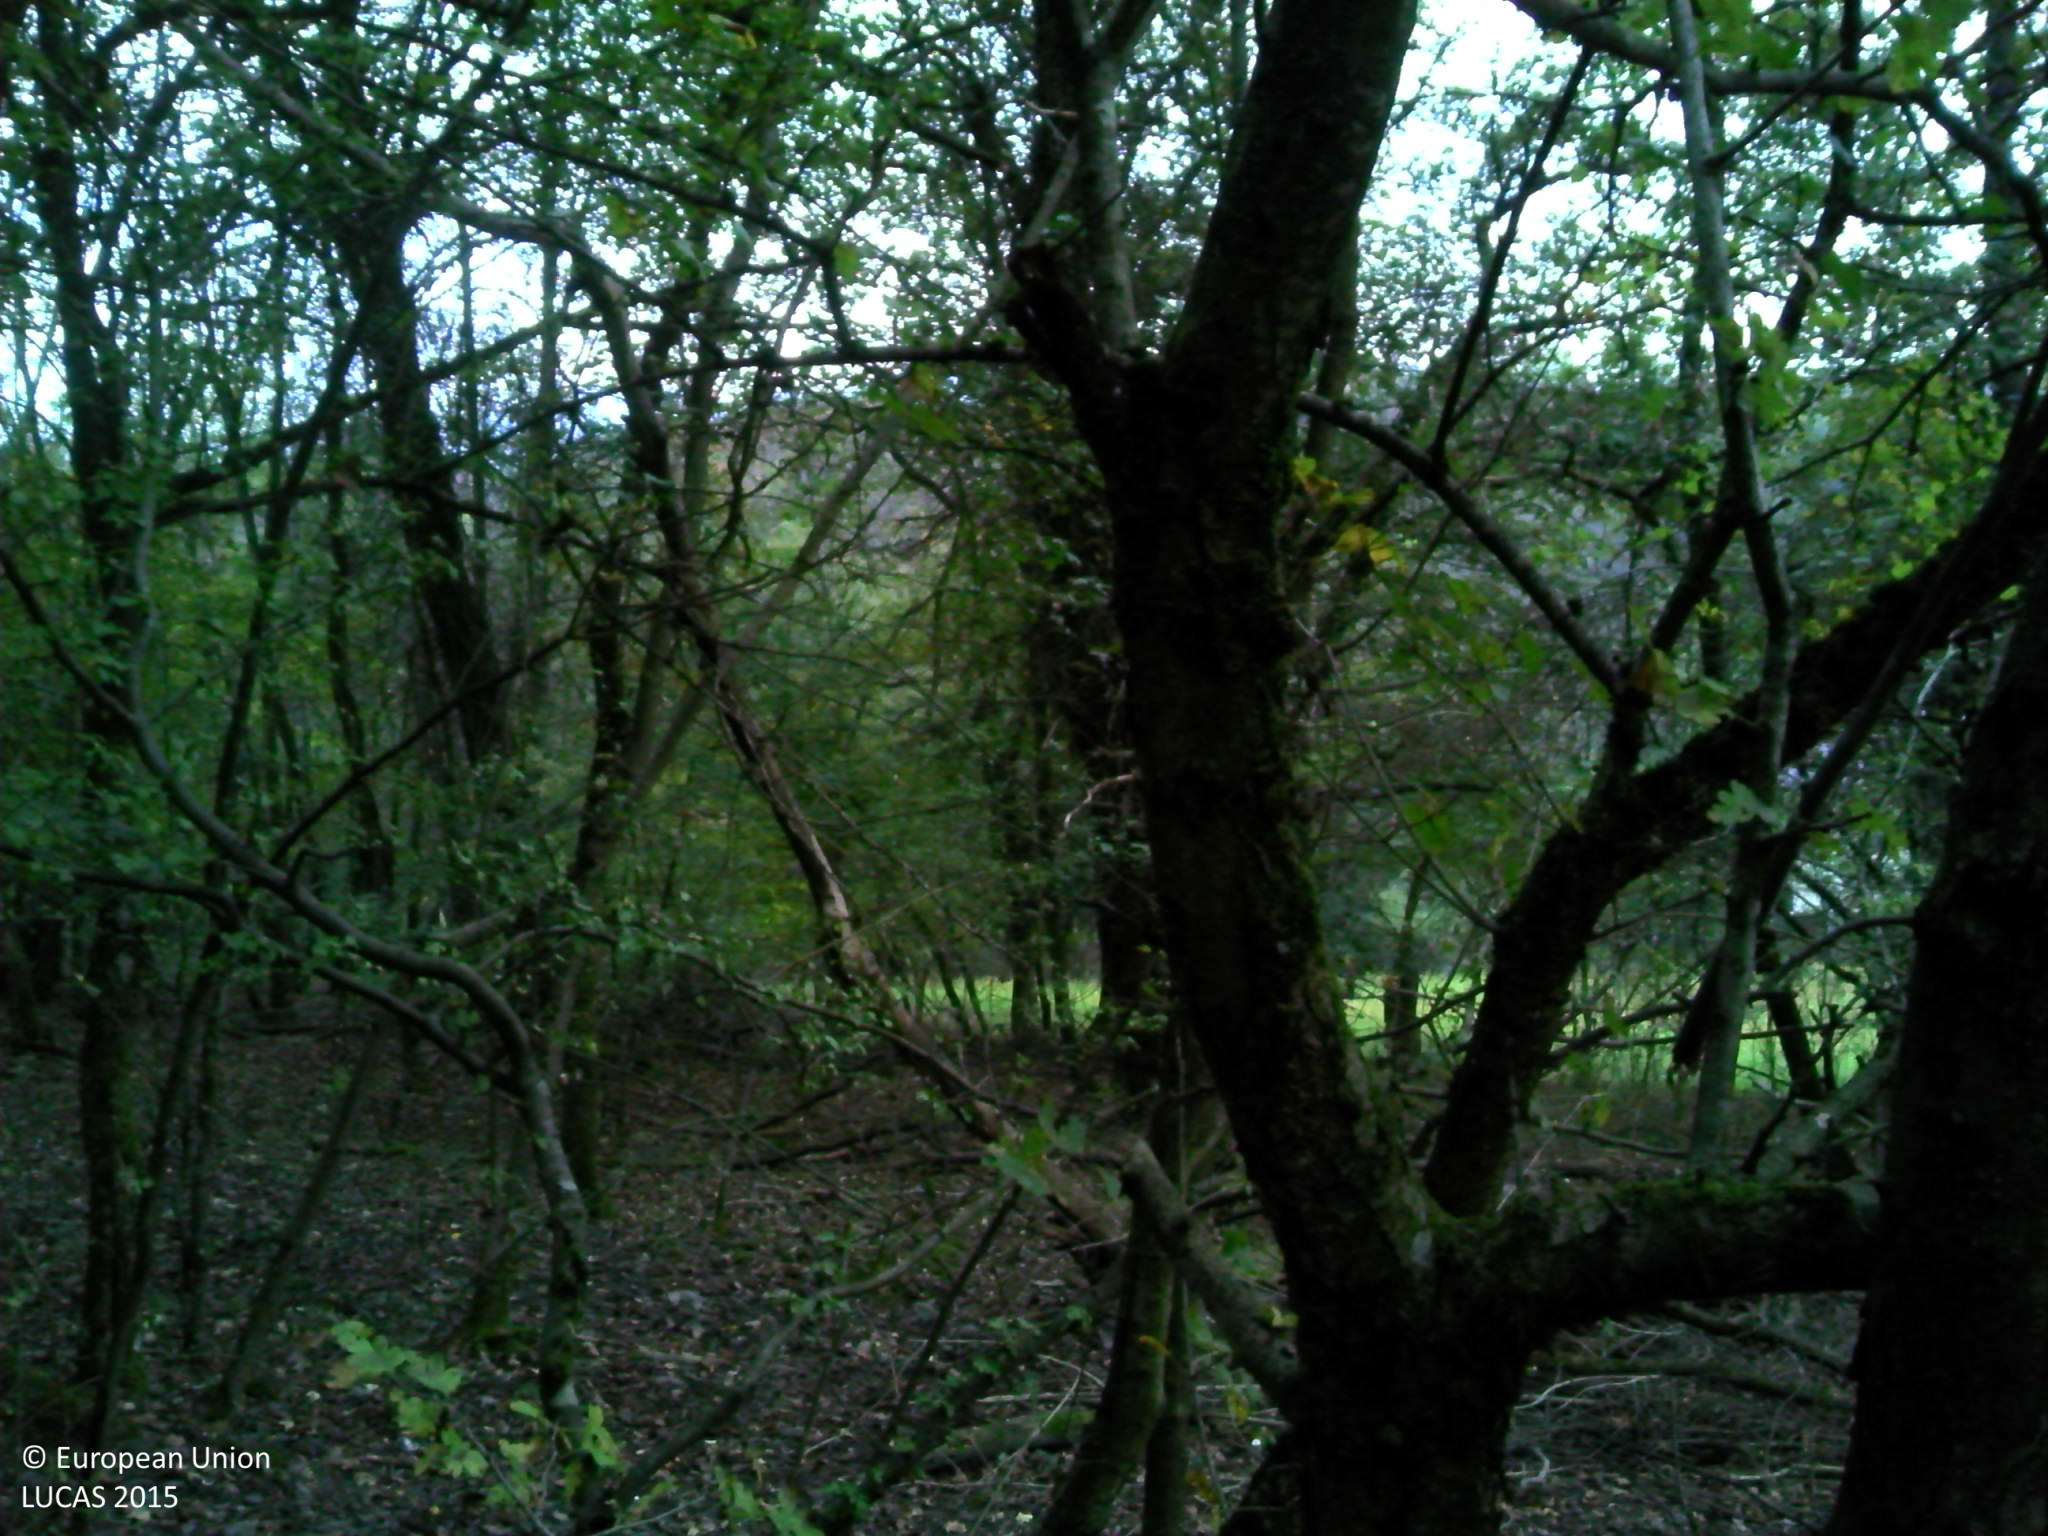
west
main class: Woodland
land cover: Broadleaved woodland
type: mesophytic deciduous forest
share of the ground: > 75 %
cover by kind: broadleaved forest trees 95 %, consolidated bare surface 5 %
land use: Forestry
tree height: > 5 m
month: October
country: FR
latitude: 45.4751
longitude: 6.2822
